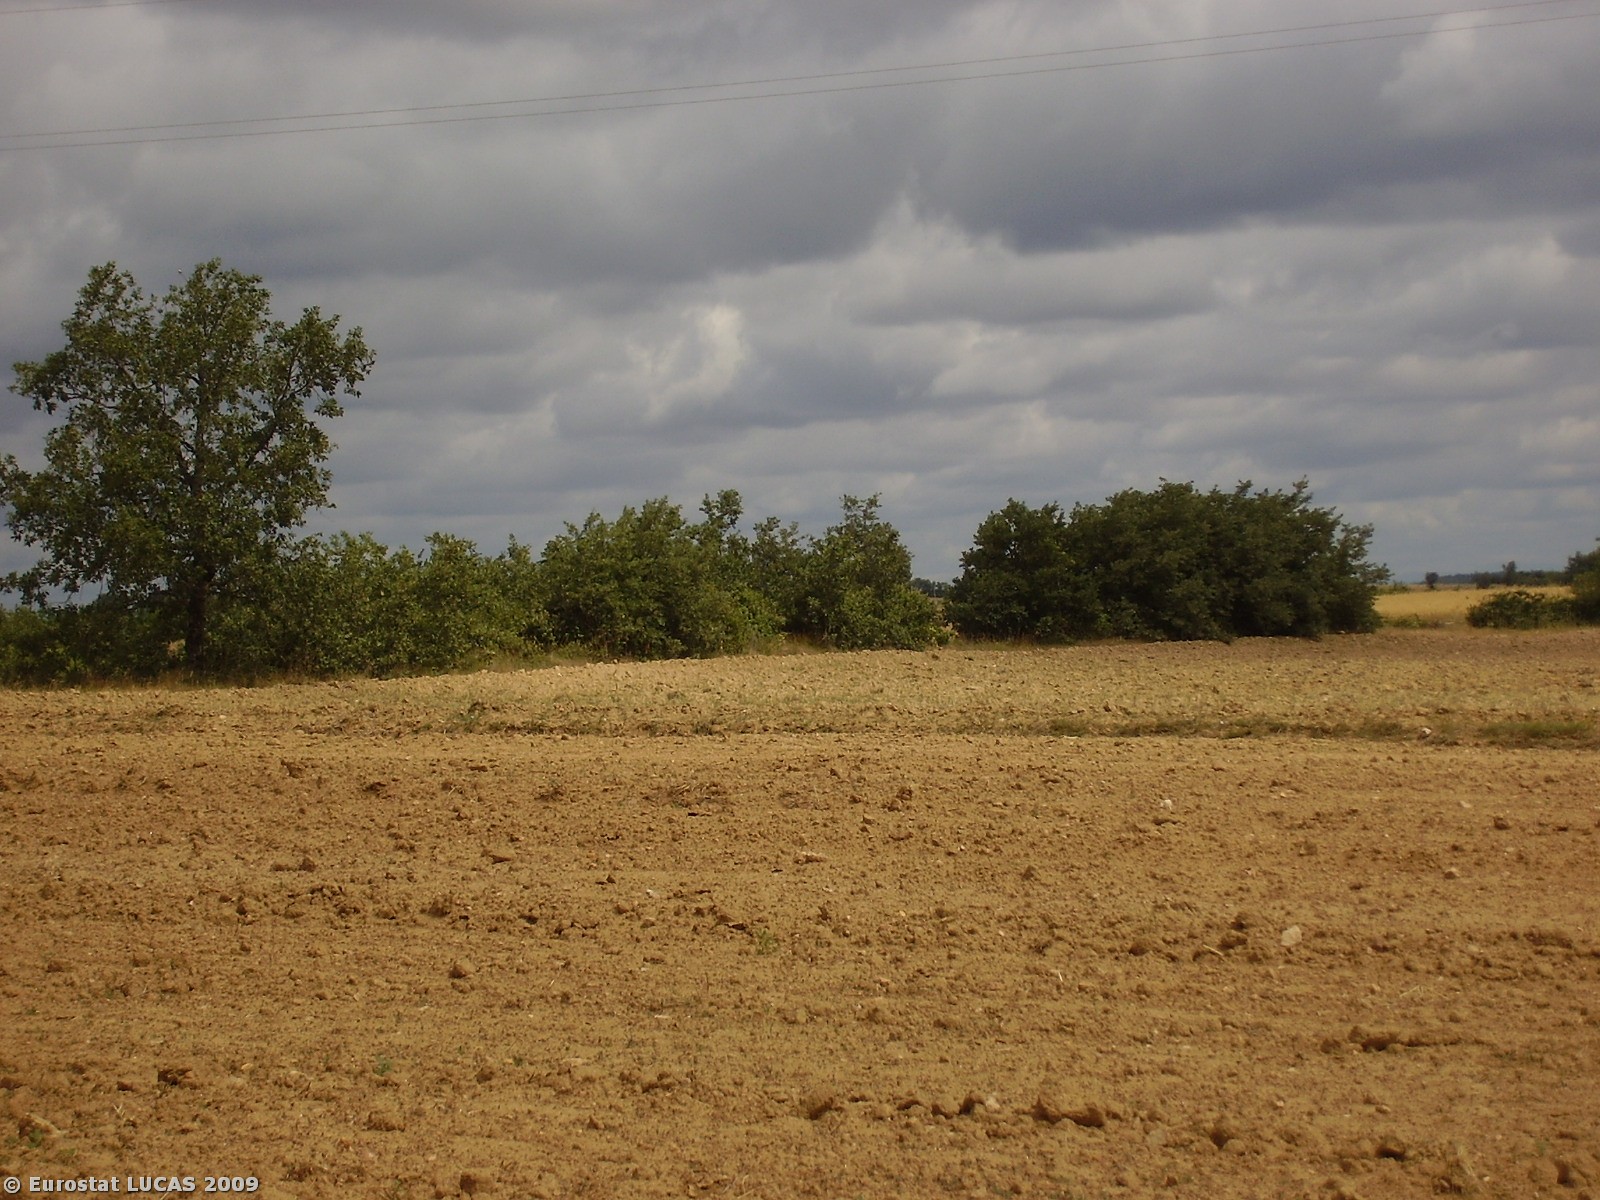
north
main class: Cropland
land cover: Other fresh vegetables
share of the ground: < 10 %
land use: Agriculture (excluding fallow land and kitchen gardens)
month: June
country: PT
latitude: 41.5371
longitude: -6.3411
